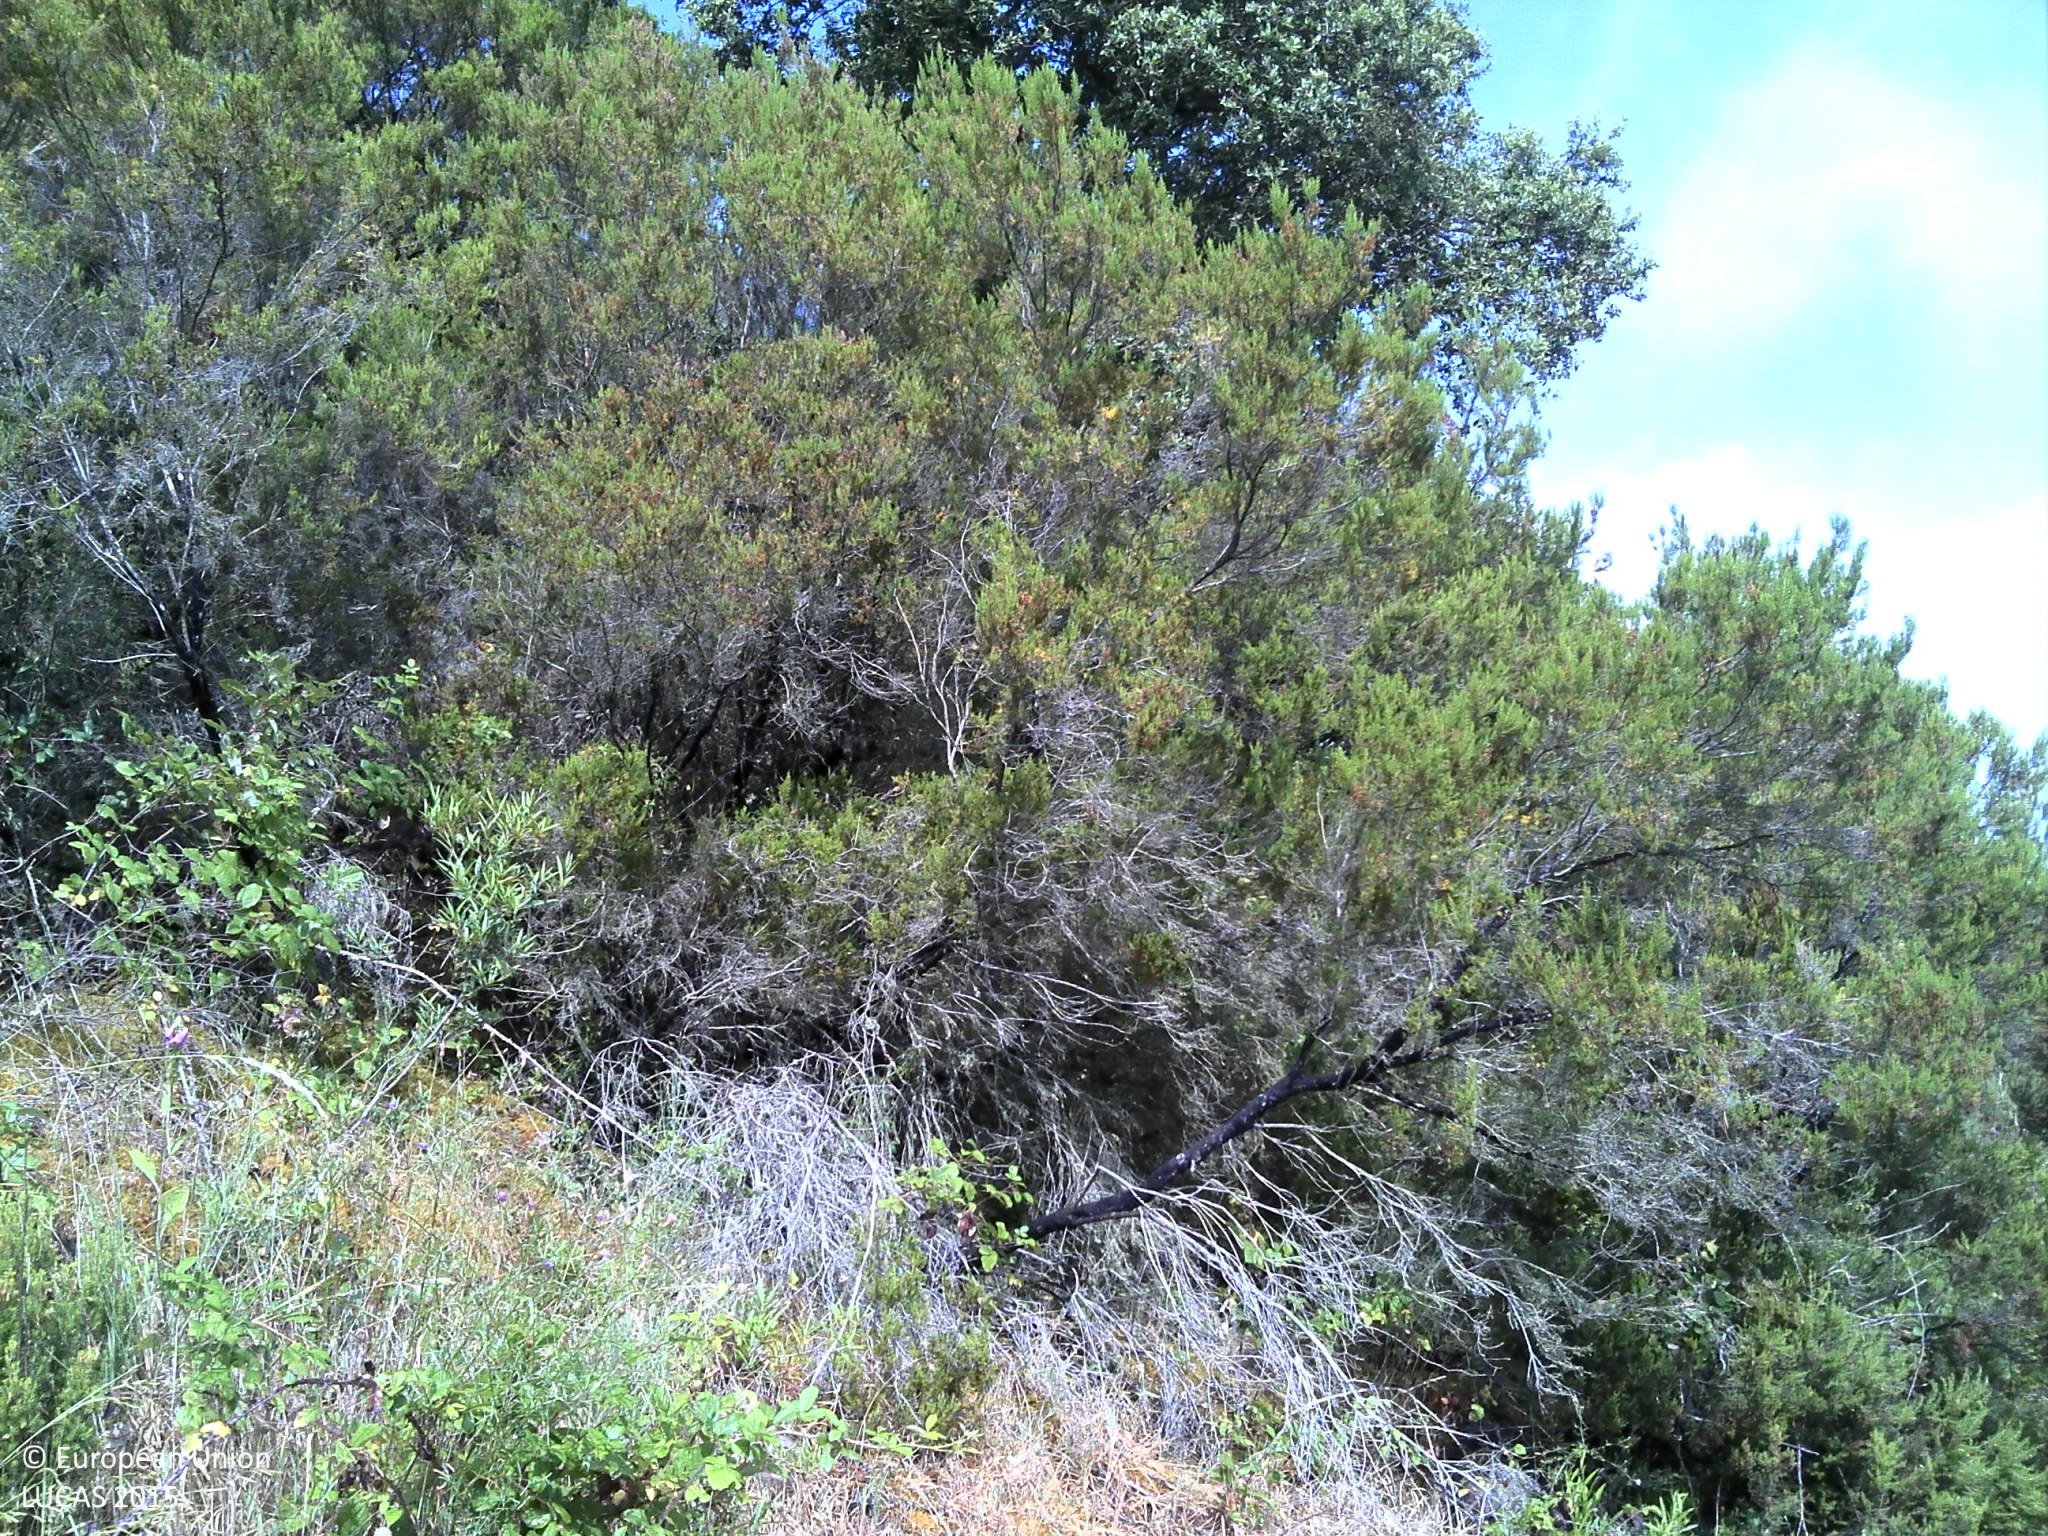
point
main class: Woodland
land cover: Pine dominated coniferous woodland
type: coniferous forest of the mediterranean region
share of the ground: < 10 %
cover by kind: shrubs 90 %, coniferous forest trees 10 %
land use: Forestry
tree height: > 5 m
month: June
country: PT
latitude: 41.1779
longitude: -7.4657
